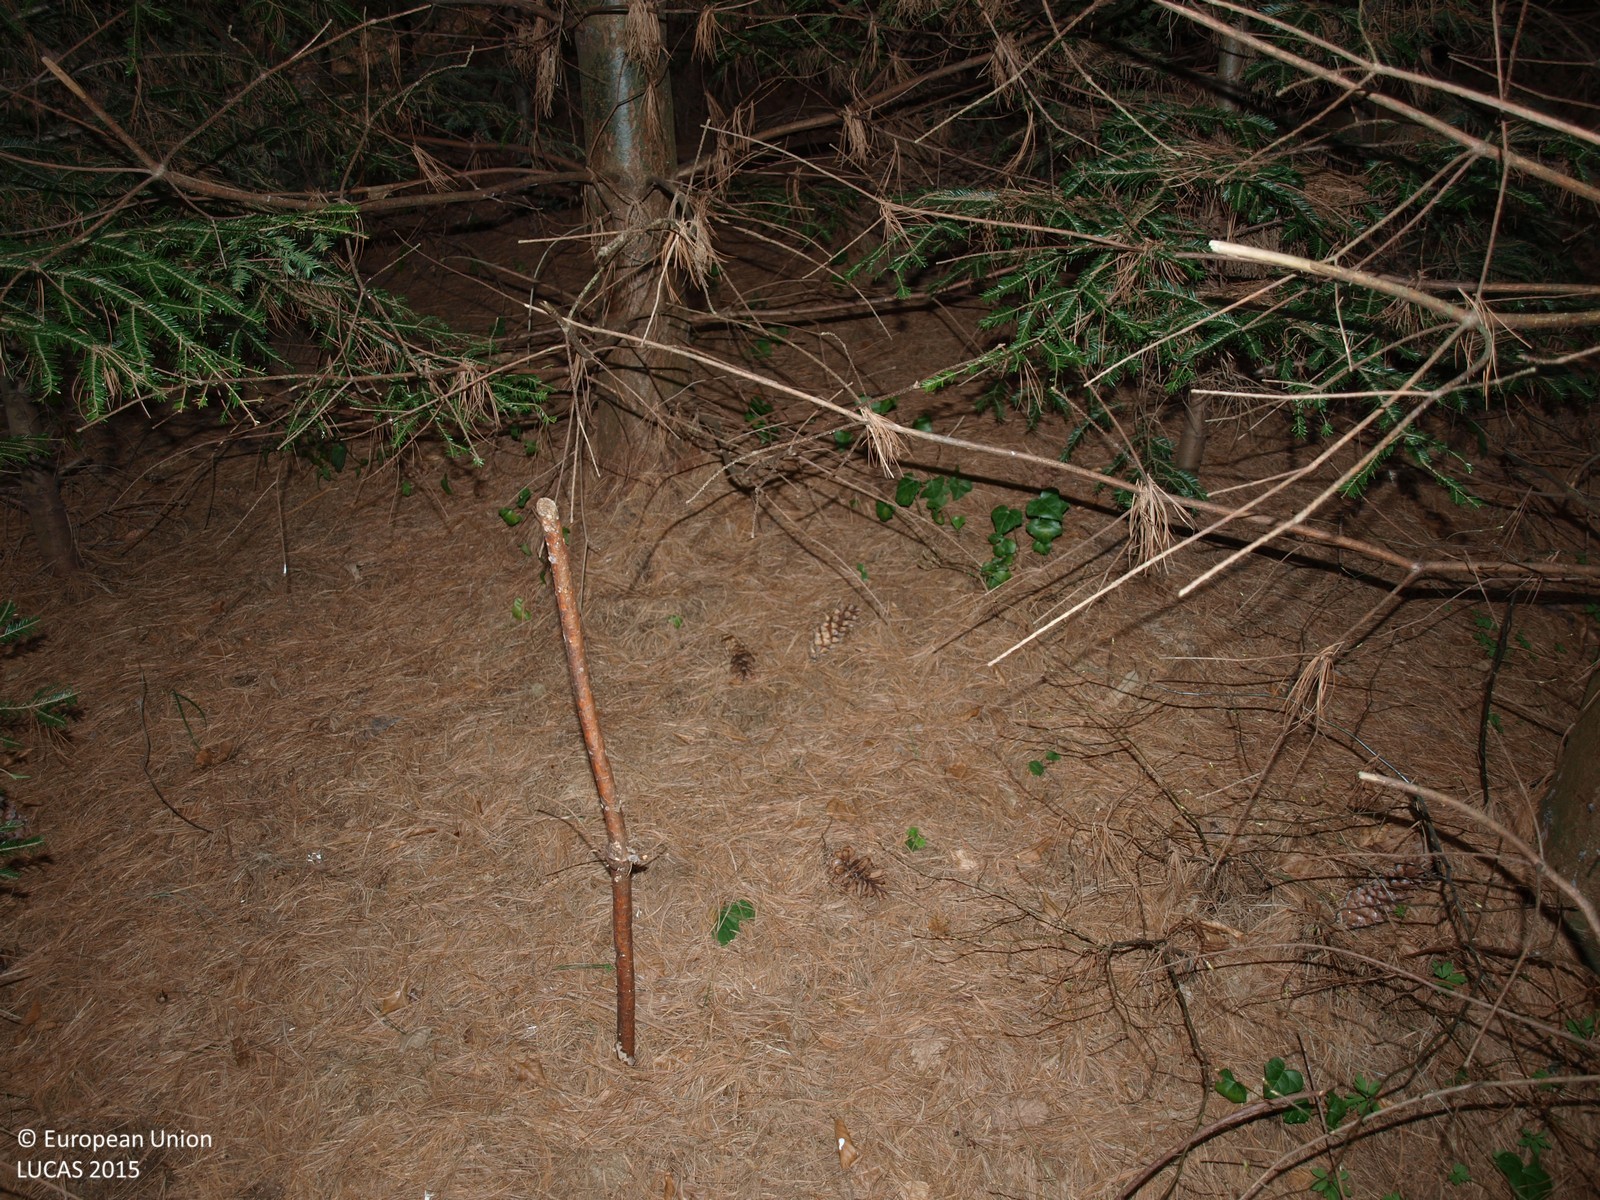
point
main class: Woodland
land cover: Spruce dominated coniferous woodland
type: hemiboreal forest and nemoral coniferous forest and mixed broadleaved-coniferous forest
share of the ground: > 75 %
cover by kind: coniferous forest trees 90 %, shrubs 5 %, herbaceous plants 5 %
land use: Forestry
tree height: > 5 m
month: March
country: HR
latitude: 46.2070
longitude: 16.2078
